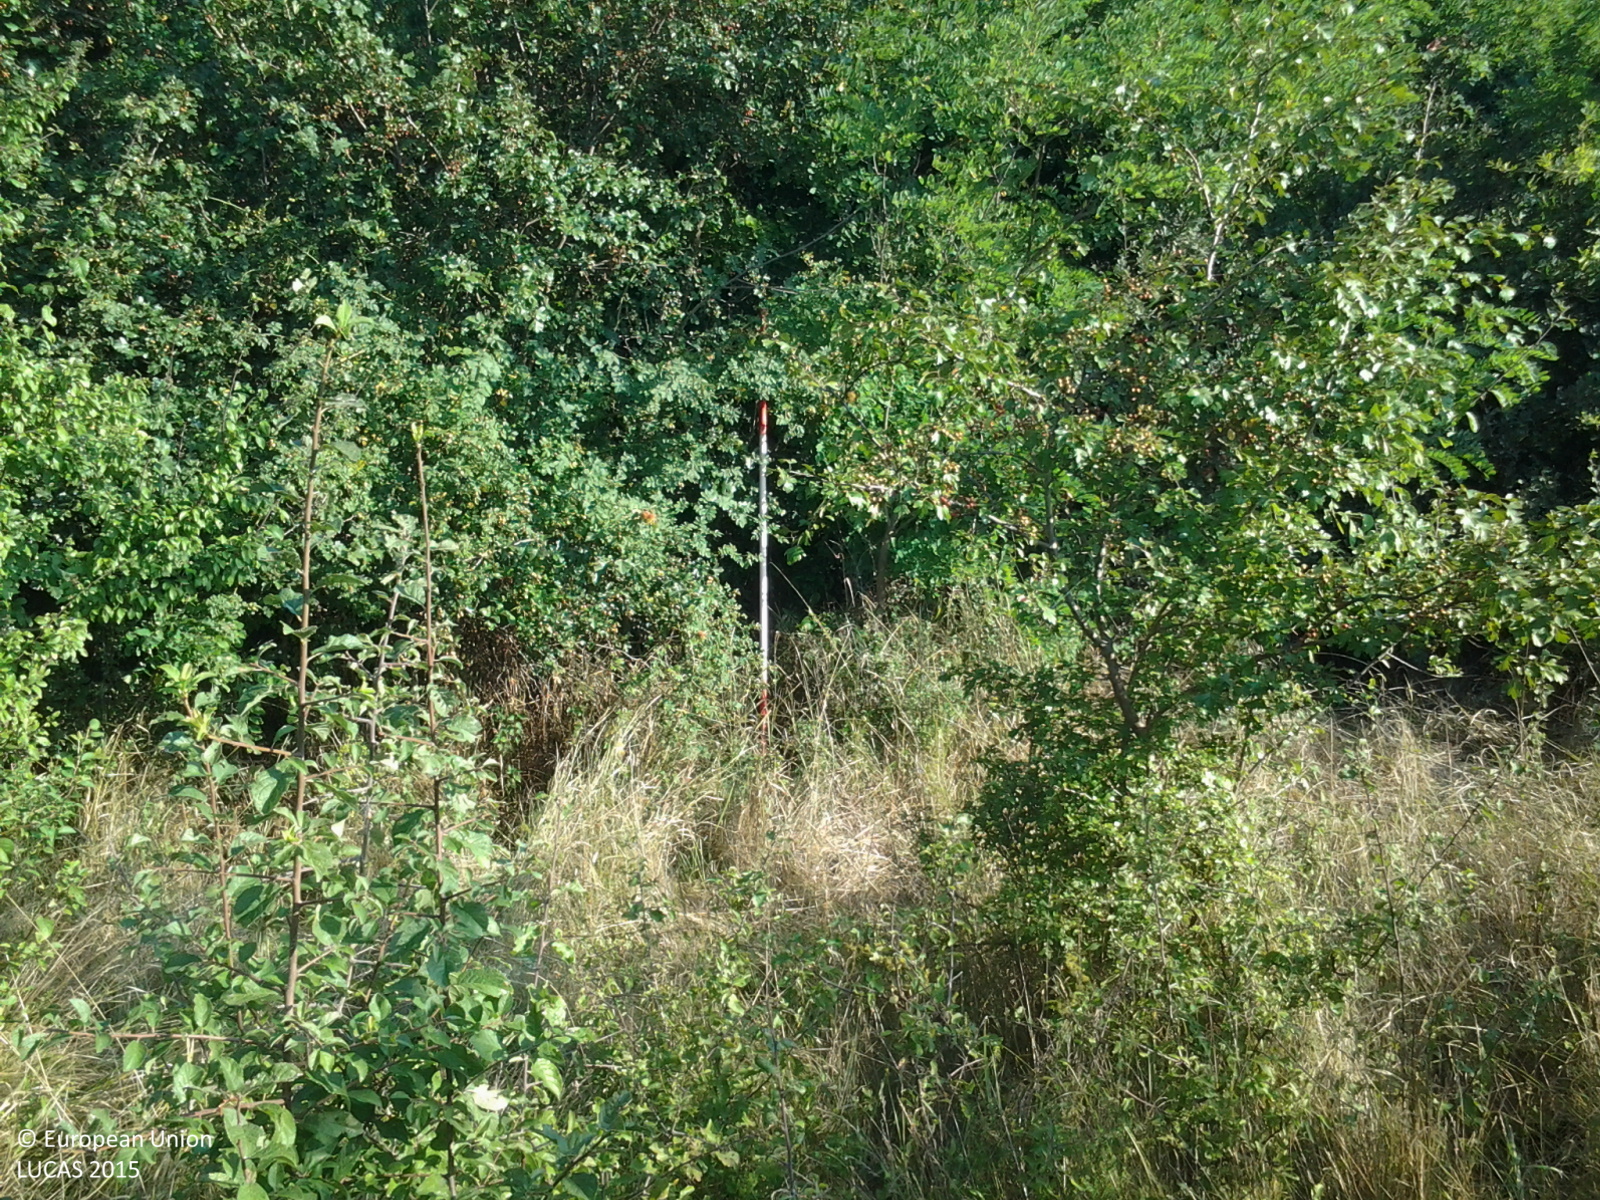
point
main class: Woodland
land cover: Broadleaved woodland
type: mesophytic deciduous forest
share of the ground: > 75 %
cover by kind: broadleaved forest trees 65 %, shrubs 20 %, herbaceous plants 15 %
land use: Forestry
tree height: < 5 m
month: August
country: HU
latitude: 46.8899
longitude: 21.5238
